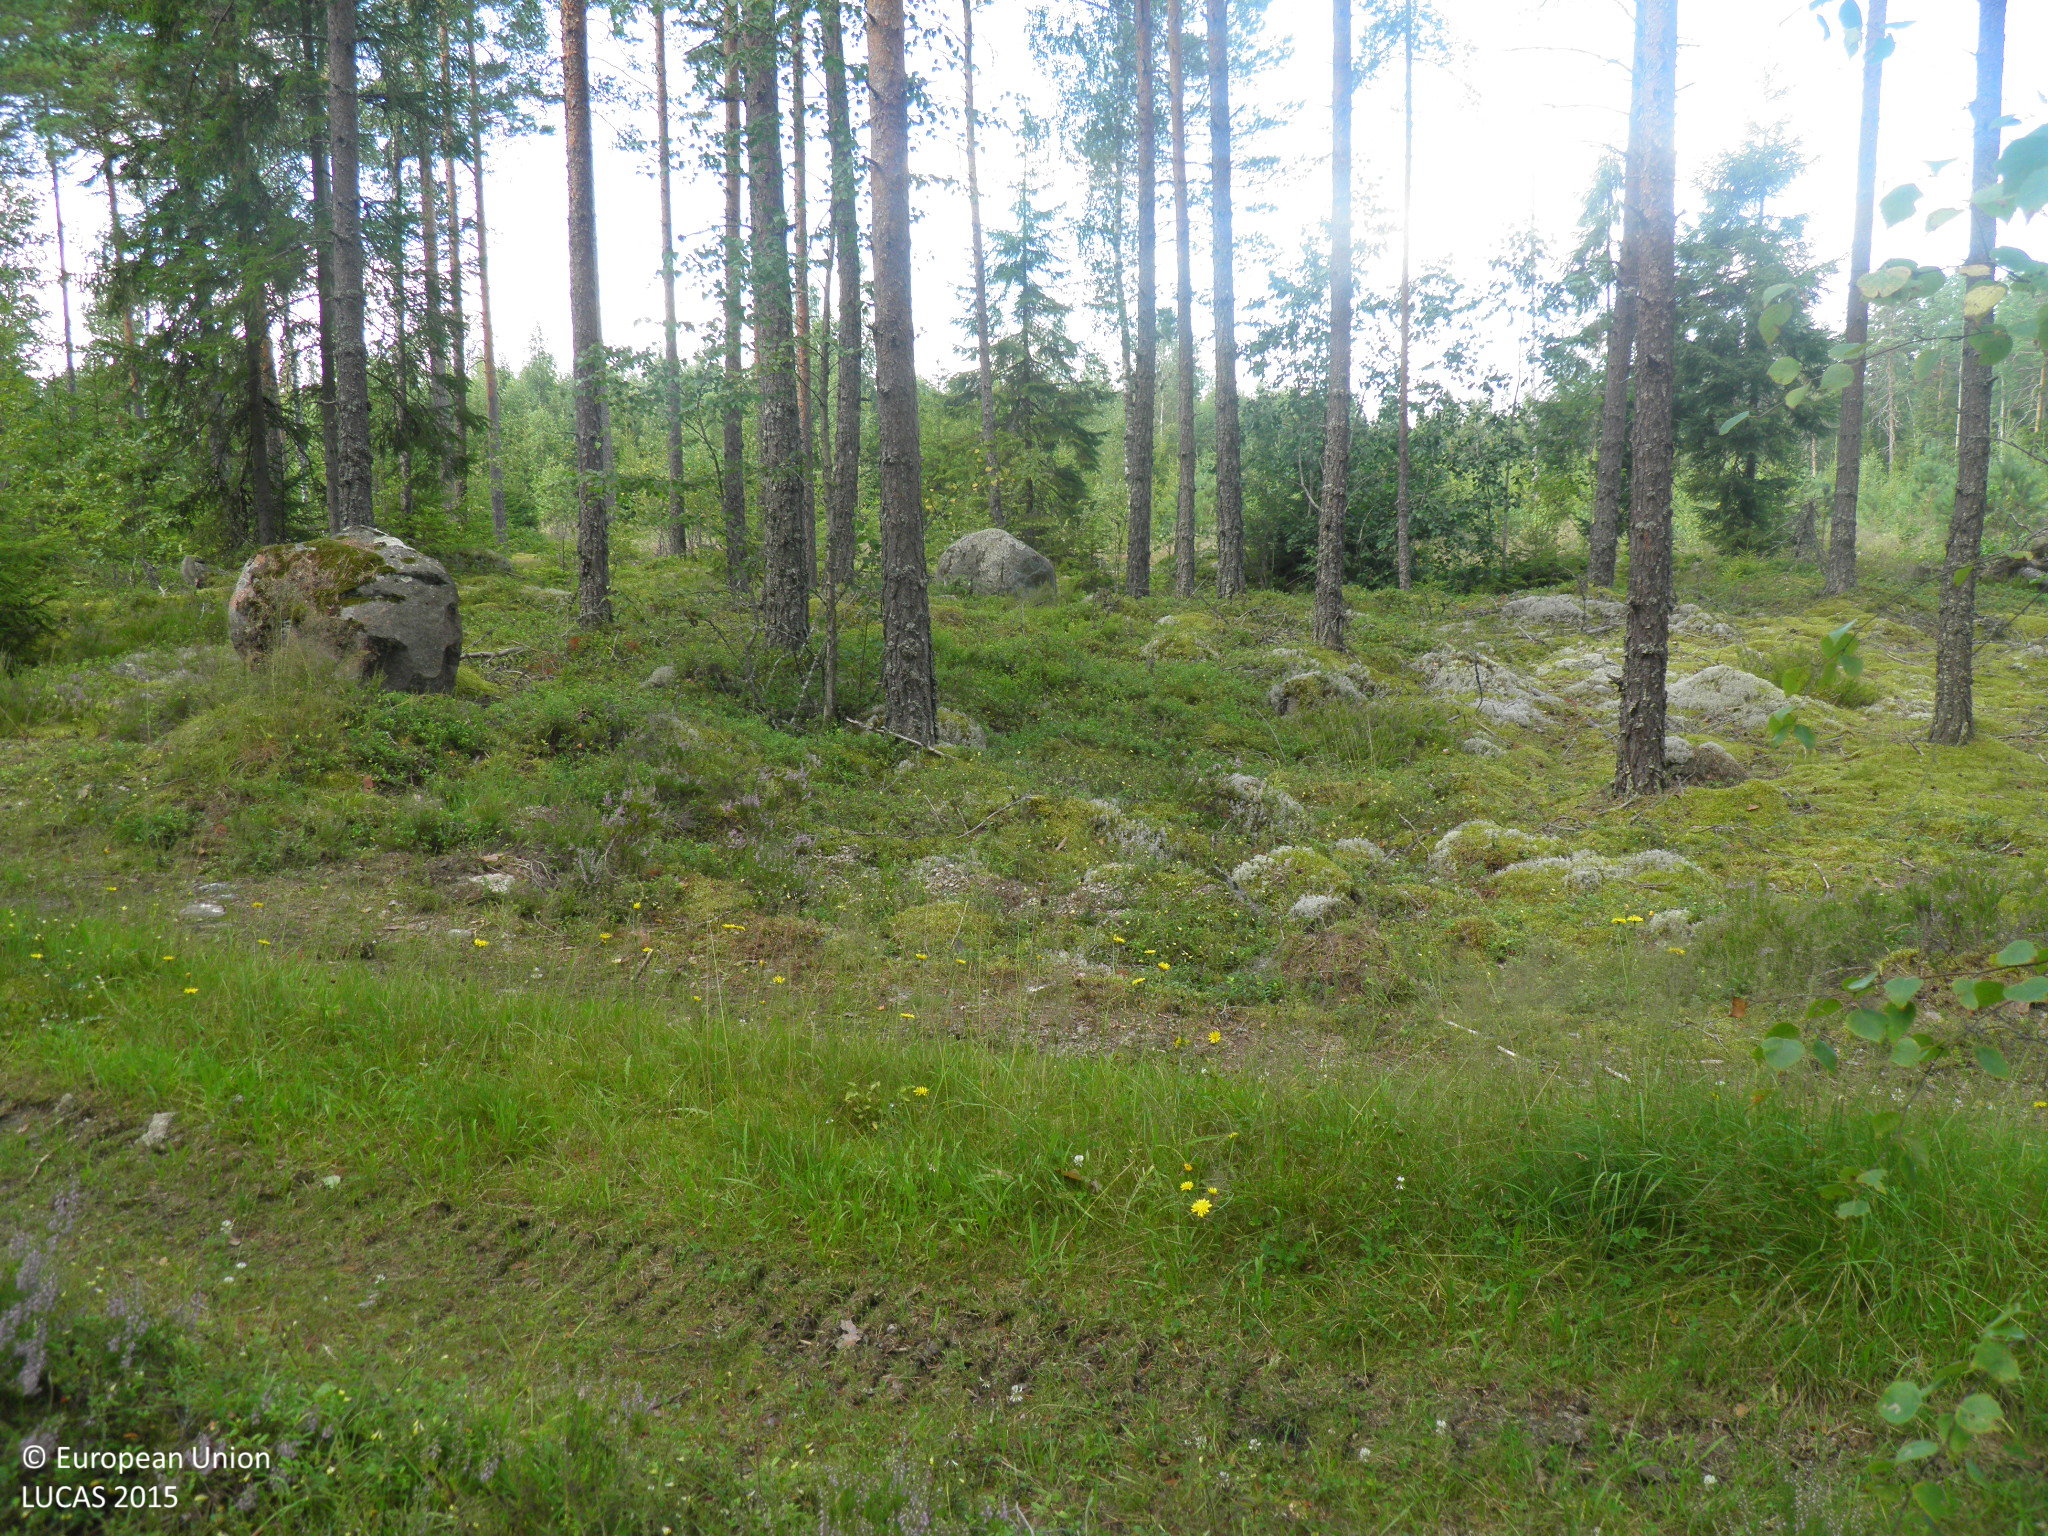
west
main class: Woodland
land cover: Pine dominated coniferous woodland
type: hemiboreal forest and nemoral coniferous forest and mixed broadleaved-coniferous forest
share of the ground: 25 - 50 %
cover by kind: coniferous forest trees 35 %, shrubs 30 %, lichens and mosses 30 %, broadleaved forest trees 5 %
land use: Forestry
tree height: > 5 m
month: August
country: FI
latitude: 61.0286
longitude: 22.0721
